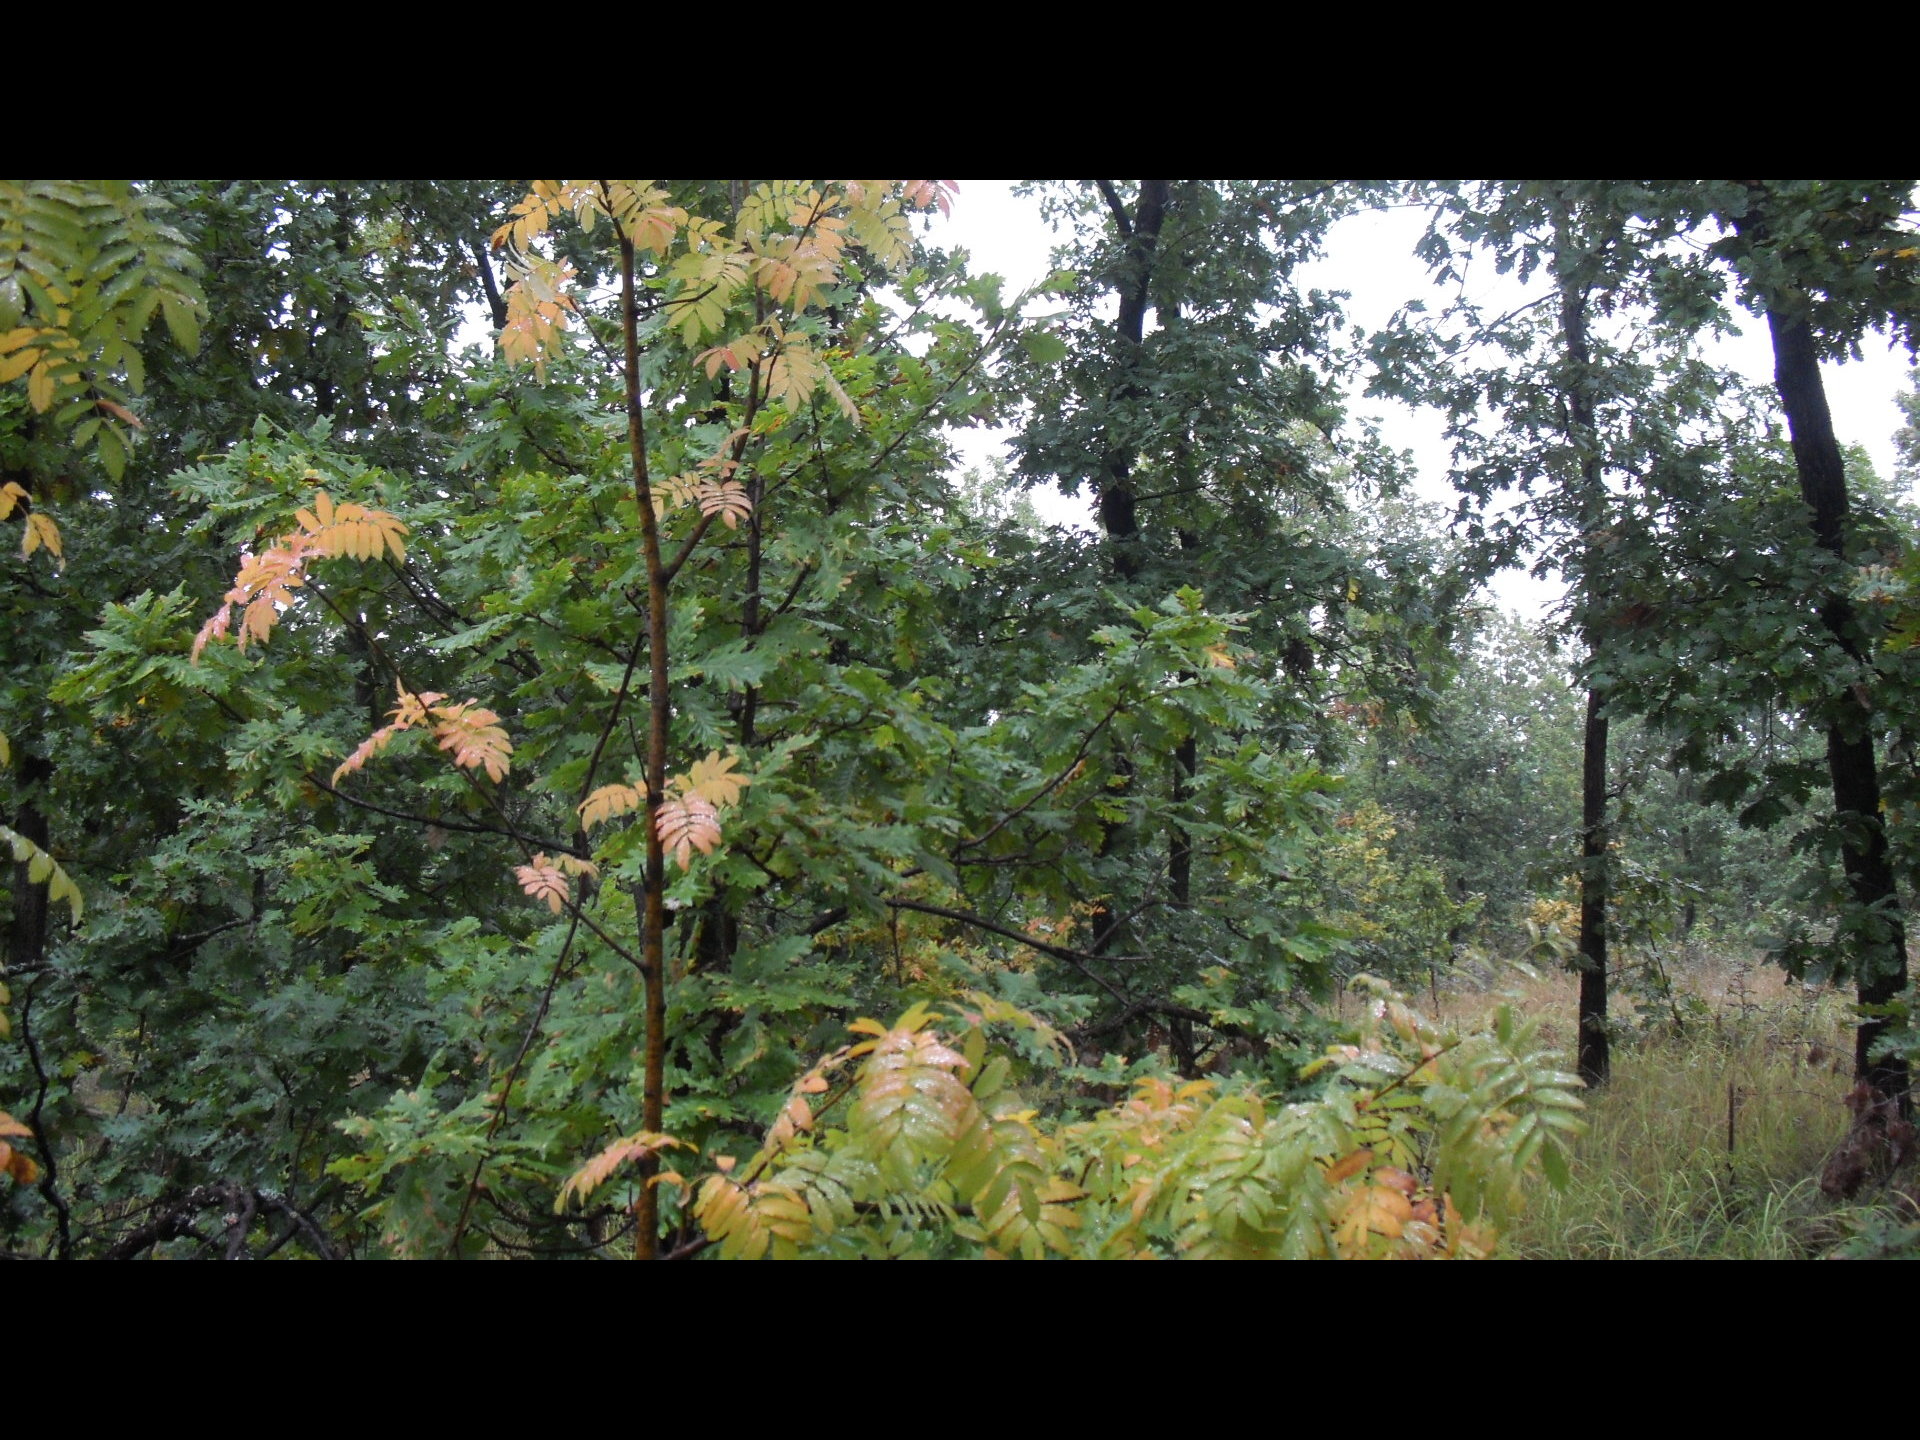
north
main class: Woodland
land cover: Broadleaved woodland
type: mesophytic deciduous forest
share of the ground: > 75 %
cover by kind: broadleaved forest trees 80 %, herbaceous plants 20 %
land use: Forestry
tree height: > 5 m
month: October
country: BG
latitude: 43.7062
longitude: 22.6046
